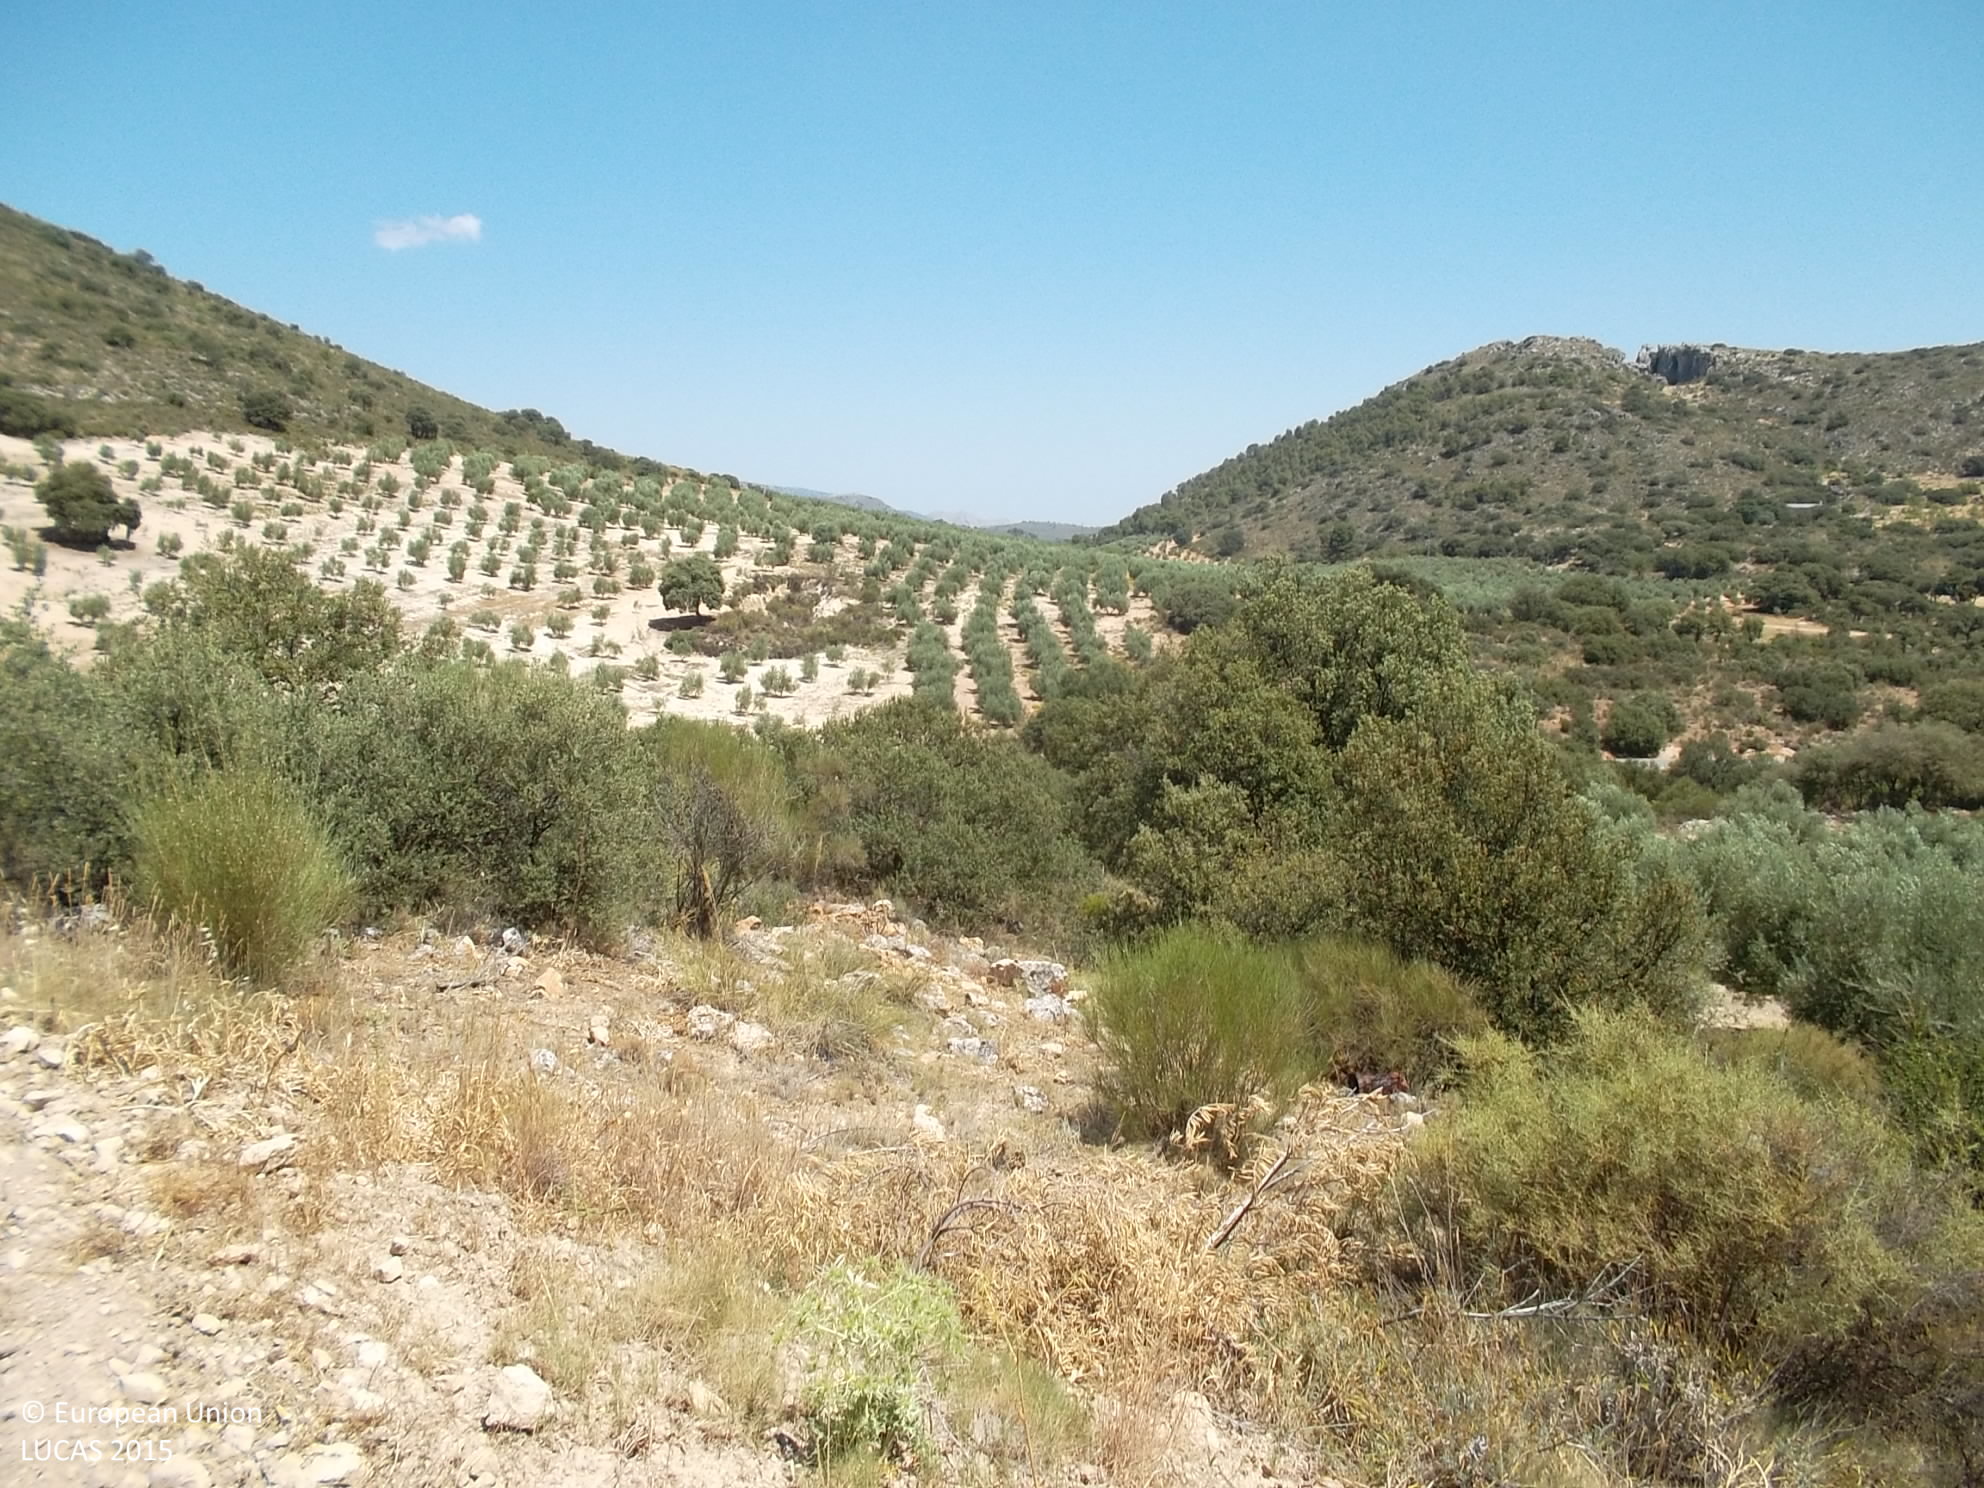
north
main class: Cropland
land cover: Olive groves
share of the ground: 10 - 25 %
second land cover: Other bare soil
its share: > 75 %
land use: Agriculture (excluding fallow land and kitchen gardens)
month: June
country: ES
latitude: 37.6659
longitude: -3.3378
